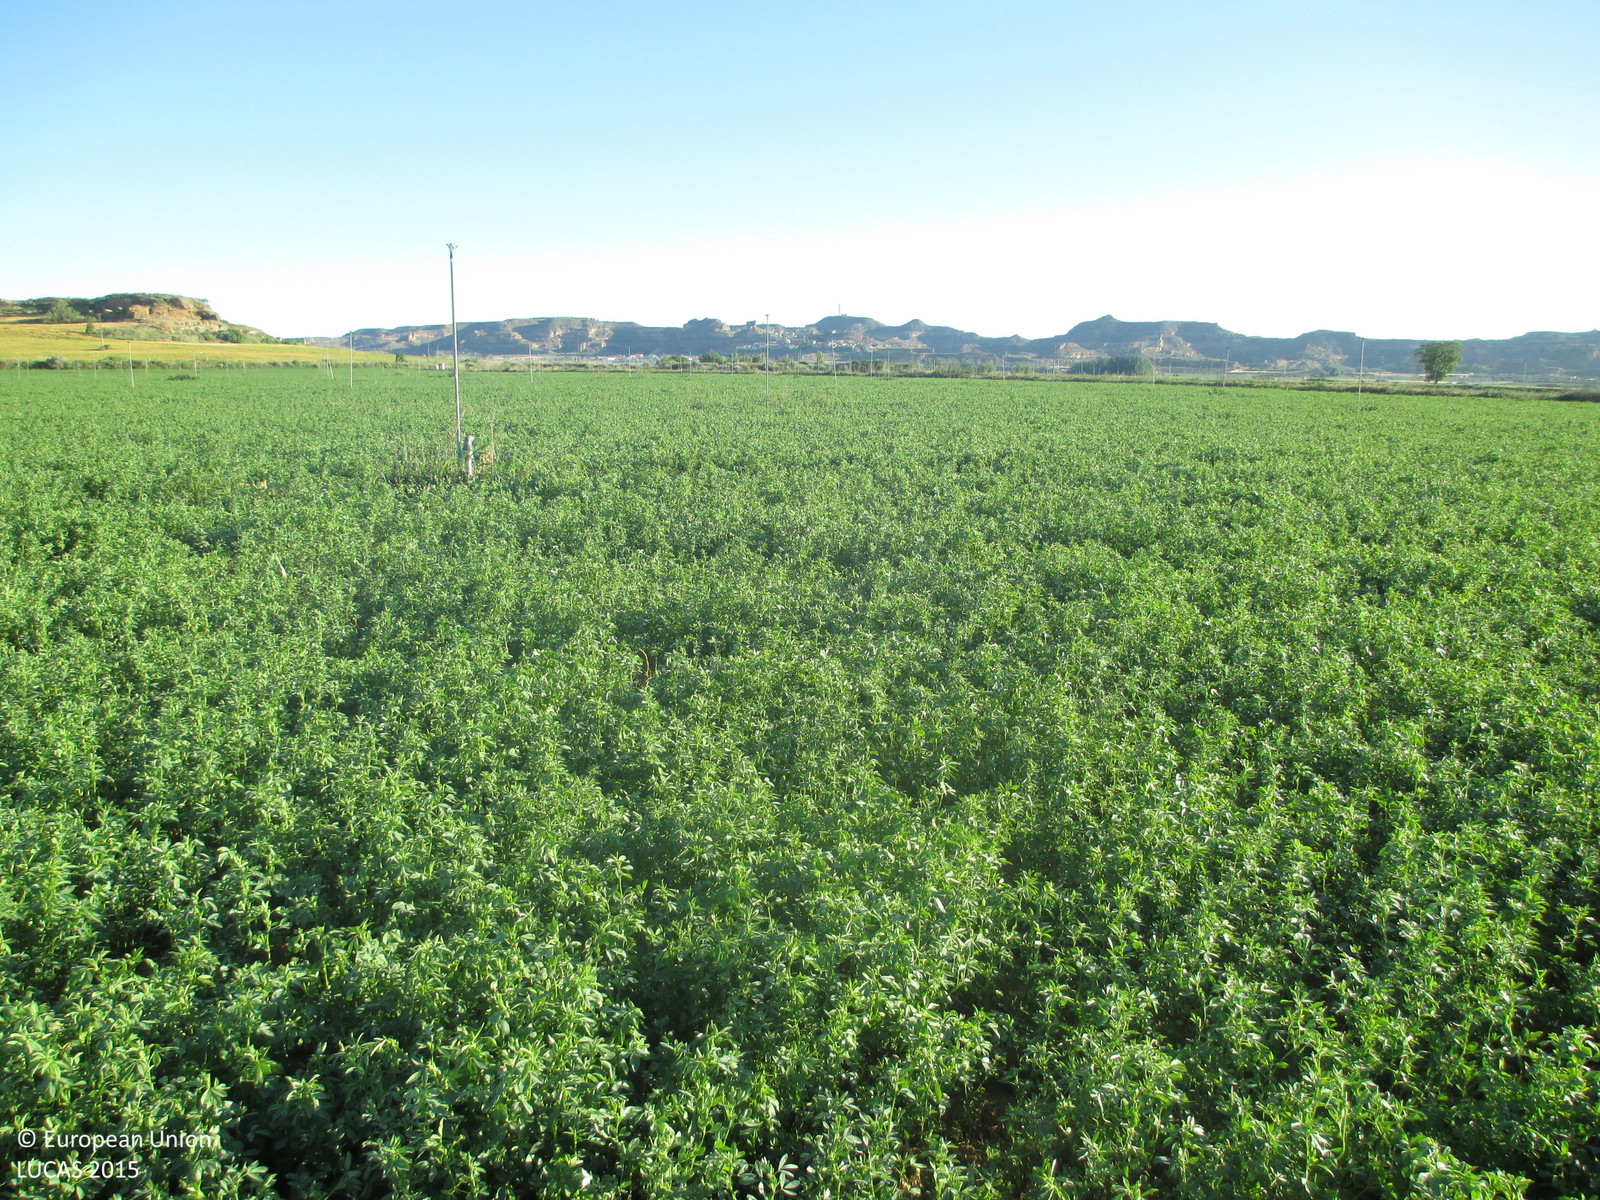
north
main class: Cropland
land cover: Lucerne
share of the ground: > 75 %
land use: Agriculture (excluding fallow land and kitchen gardens)
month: May
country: ES
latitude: 41.9804
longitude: -0.3155
